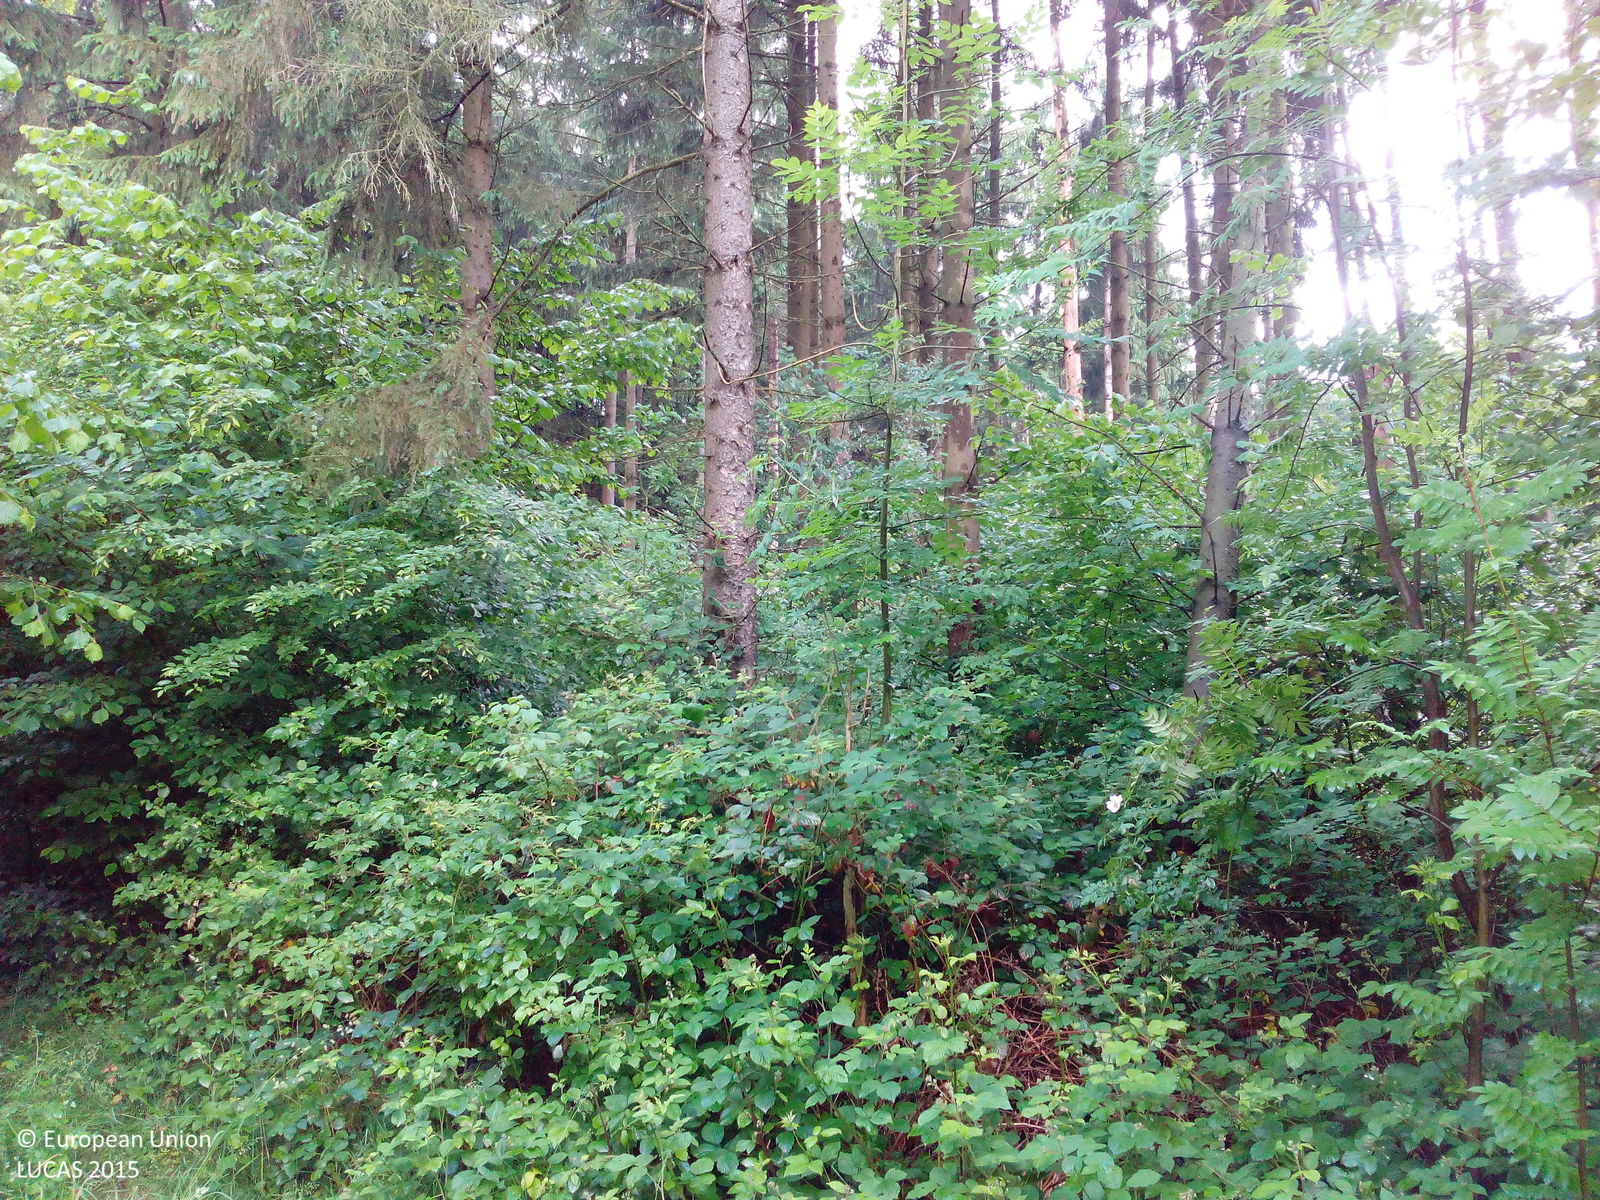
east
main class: Woodland
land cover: Spruce dominated coniferous woodland
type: hemiboreal forest and nemoral coniferous forest and mixed broadleaved-coniferous forest
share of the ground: > 75 %
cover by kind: coniferous forest trees 90 %, broadleaved forest trees 10 %
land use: Forestry
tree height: > 5 m
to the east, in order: Spruce dominated coniferous woodland; Spruce dominated mixed woodland; Tracks; Spruce dominated mixed woodland; Spruce dominated coniferous woodland; Spruce dominated mixed woodland; Tracks; Broadleaved woodland; Tracks; Broadleaved woodland; Tracks; Broadleaved woodland
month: June
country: DE
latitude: 51.9100
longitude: 9.8692
